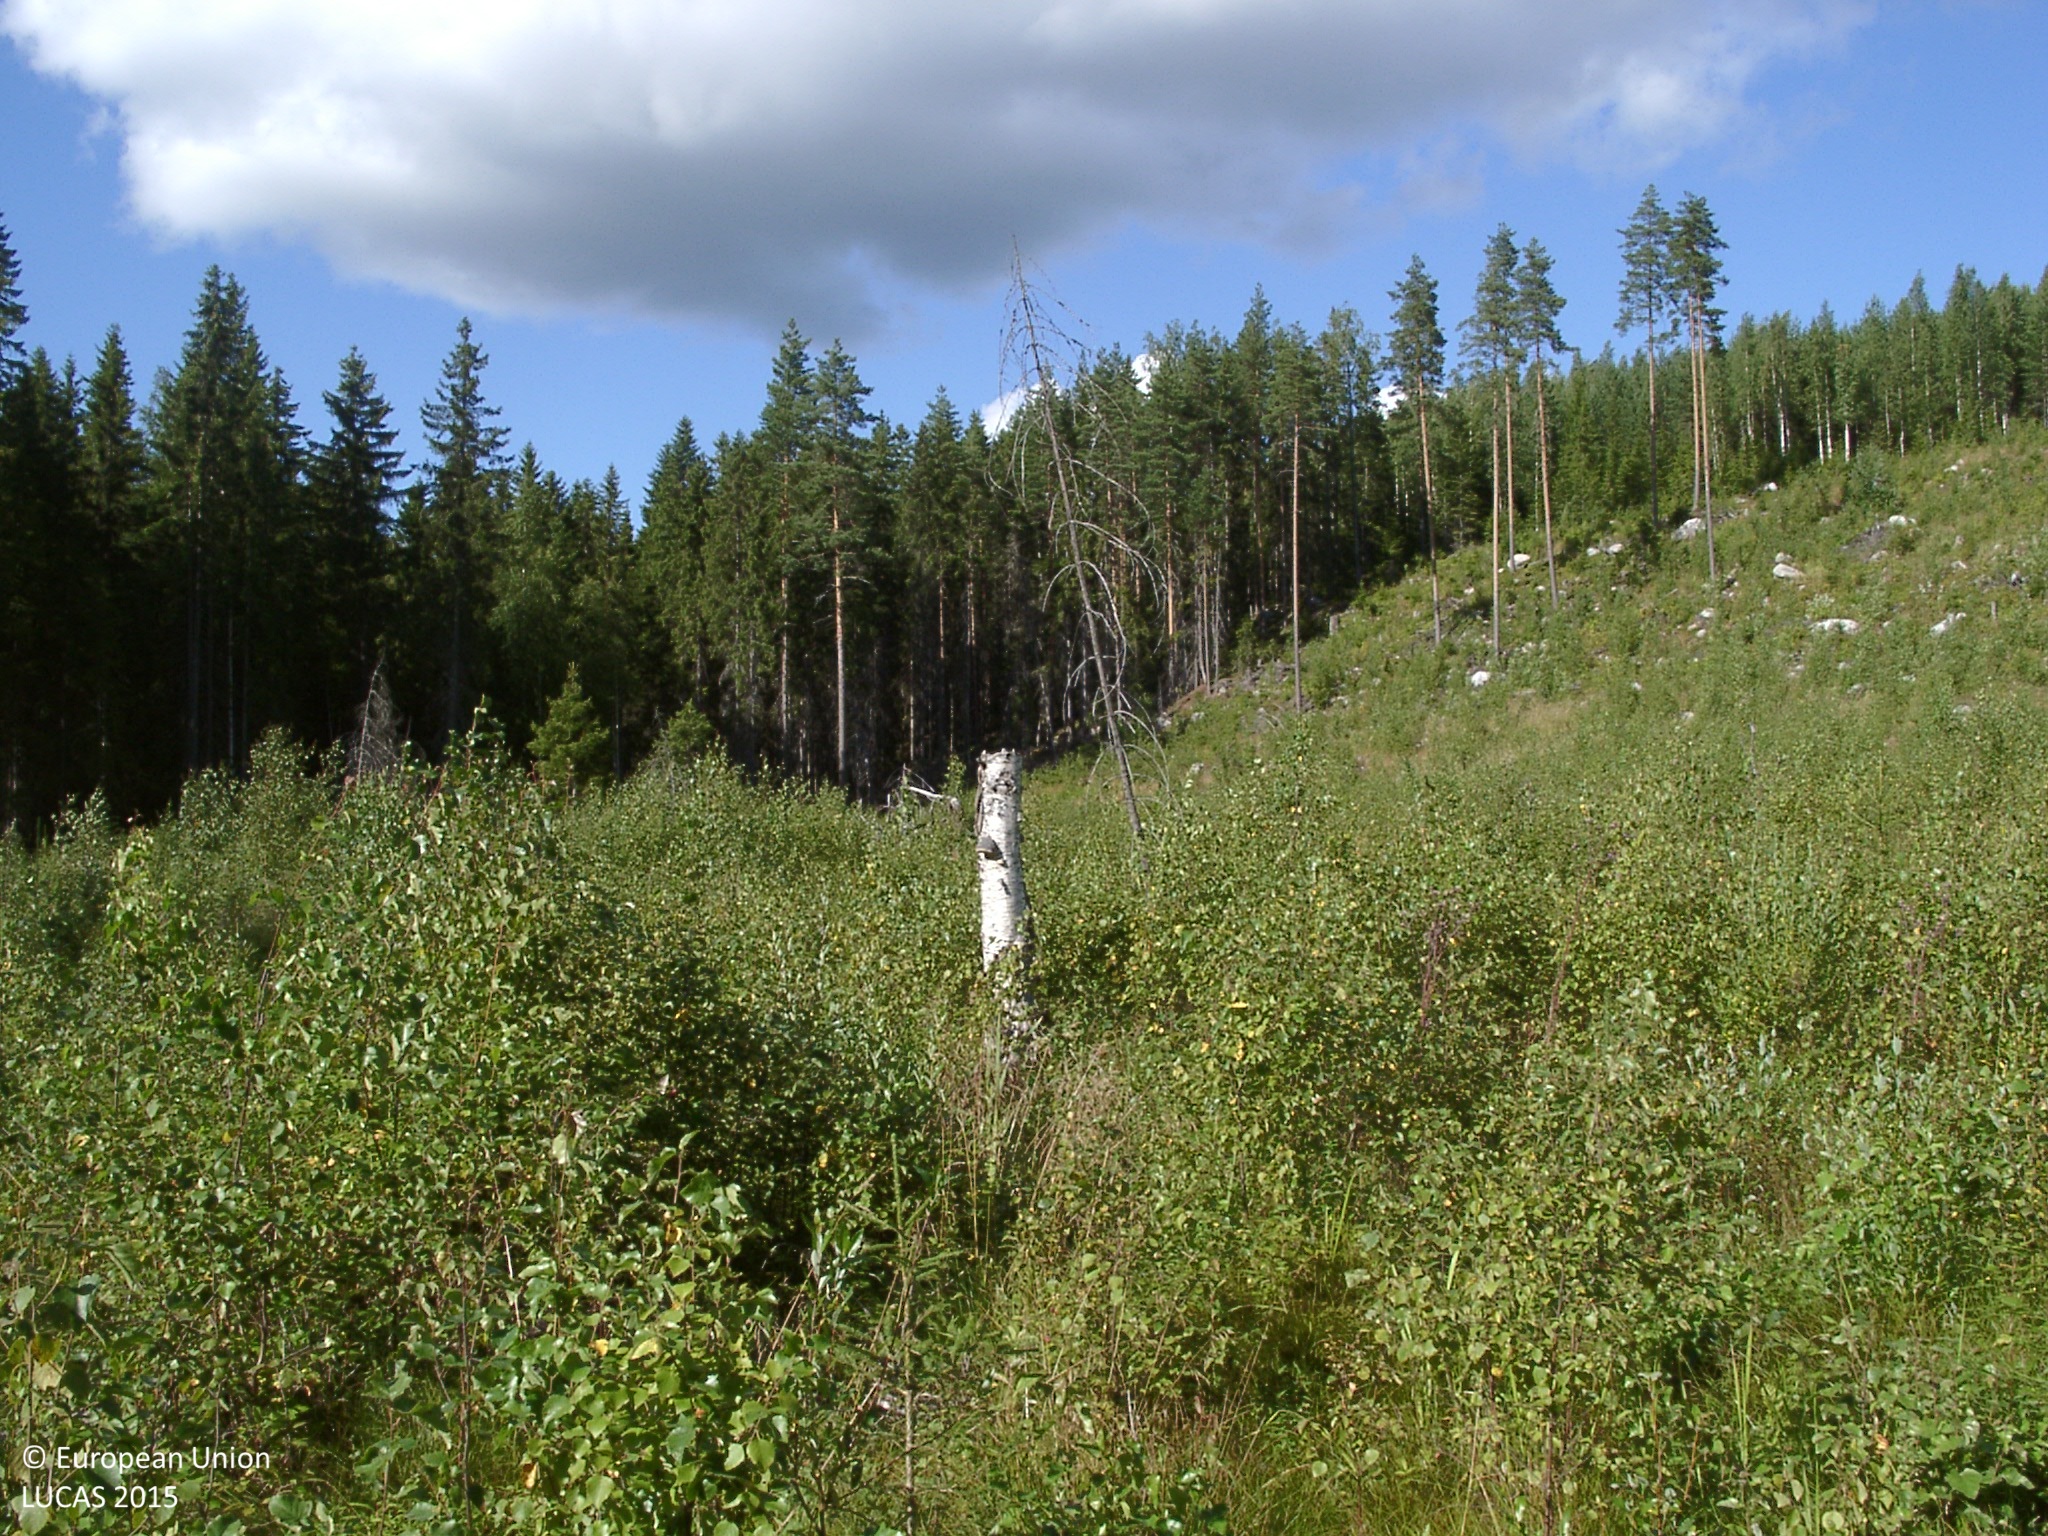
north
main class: Woodland
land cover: Broadleaved woodland
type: boreal forest
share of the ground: 50 - 75 %
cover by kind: broadleaved forest trees 50 %, herbaceous plants 30 %, shrubs 10 %, coniferous forest trees 5 %, lichens and mosses 5 %
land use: Forestry
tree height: < 5 m
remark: Nursery
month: August
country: FI
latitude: 62.4007
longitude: 25.7722
